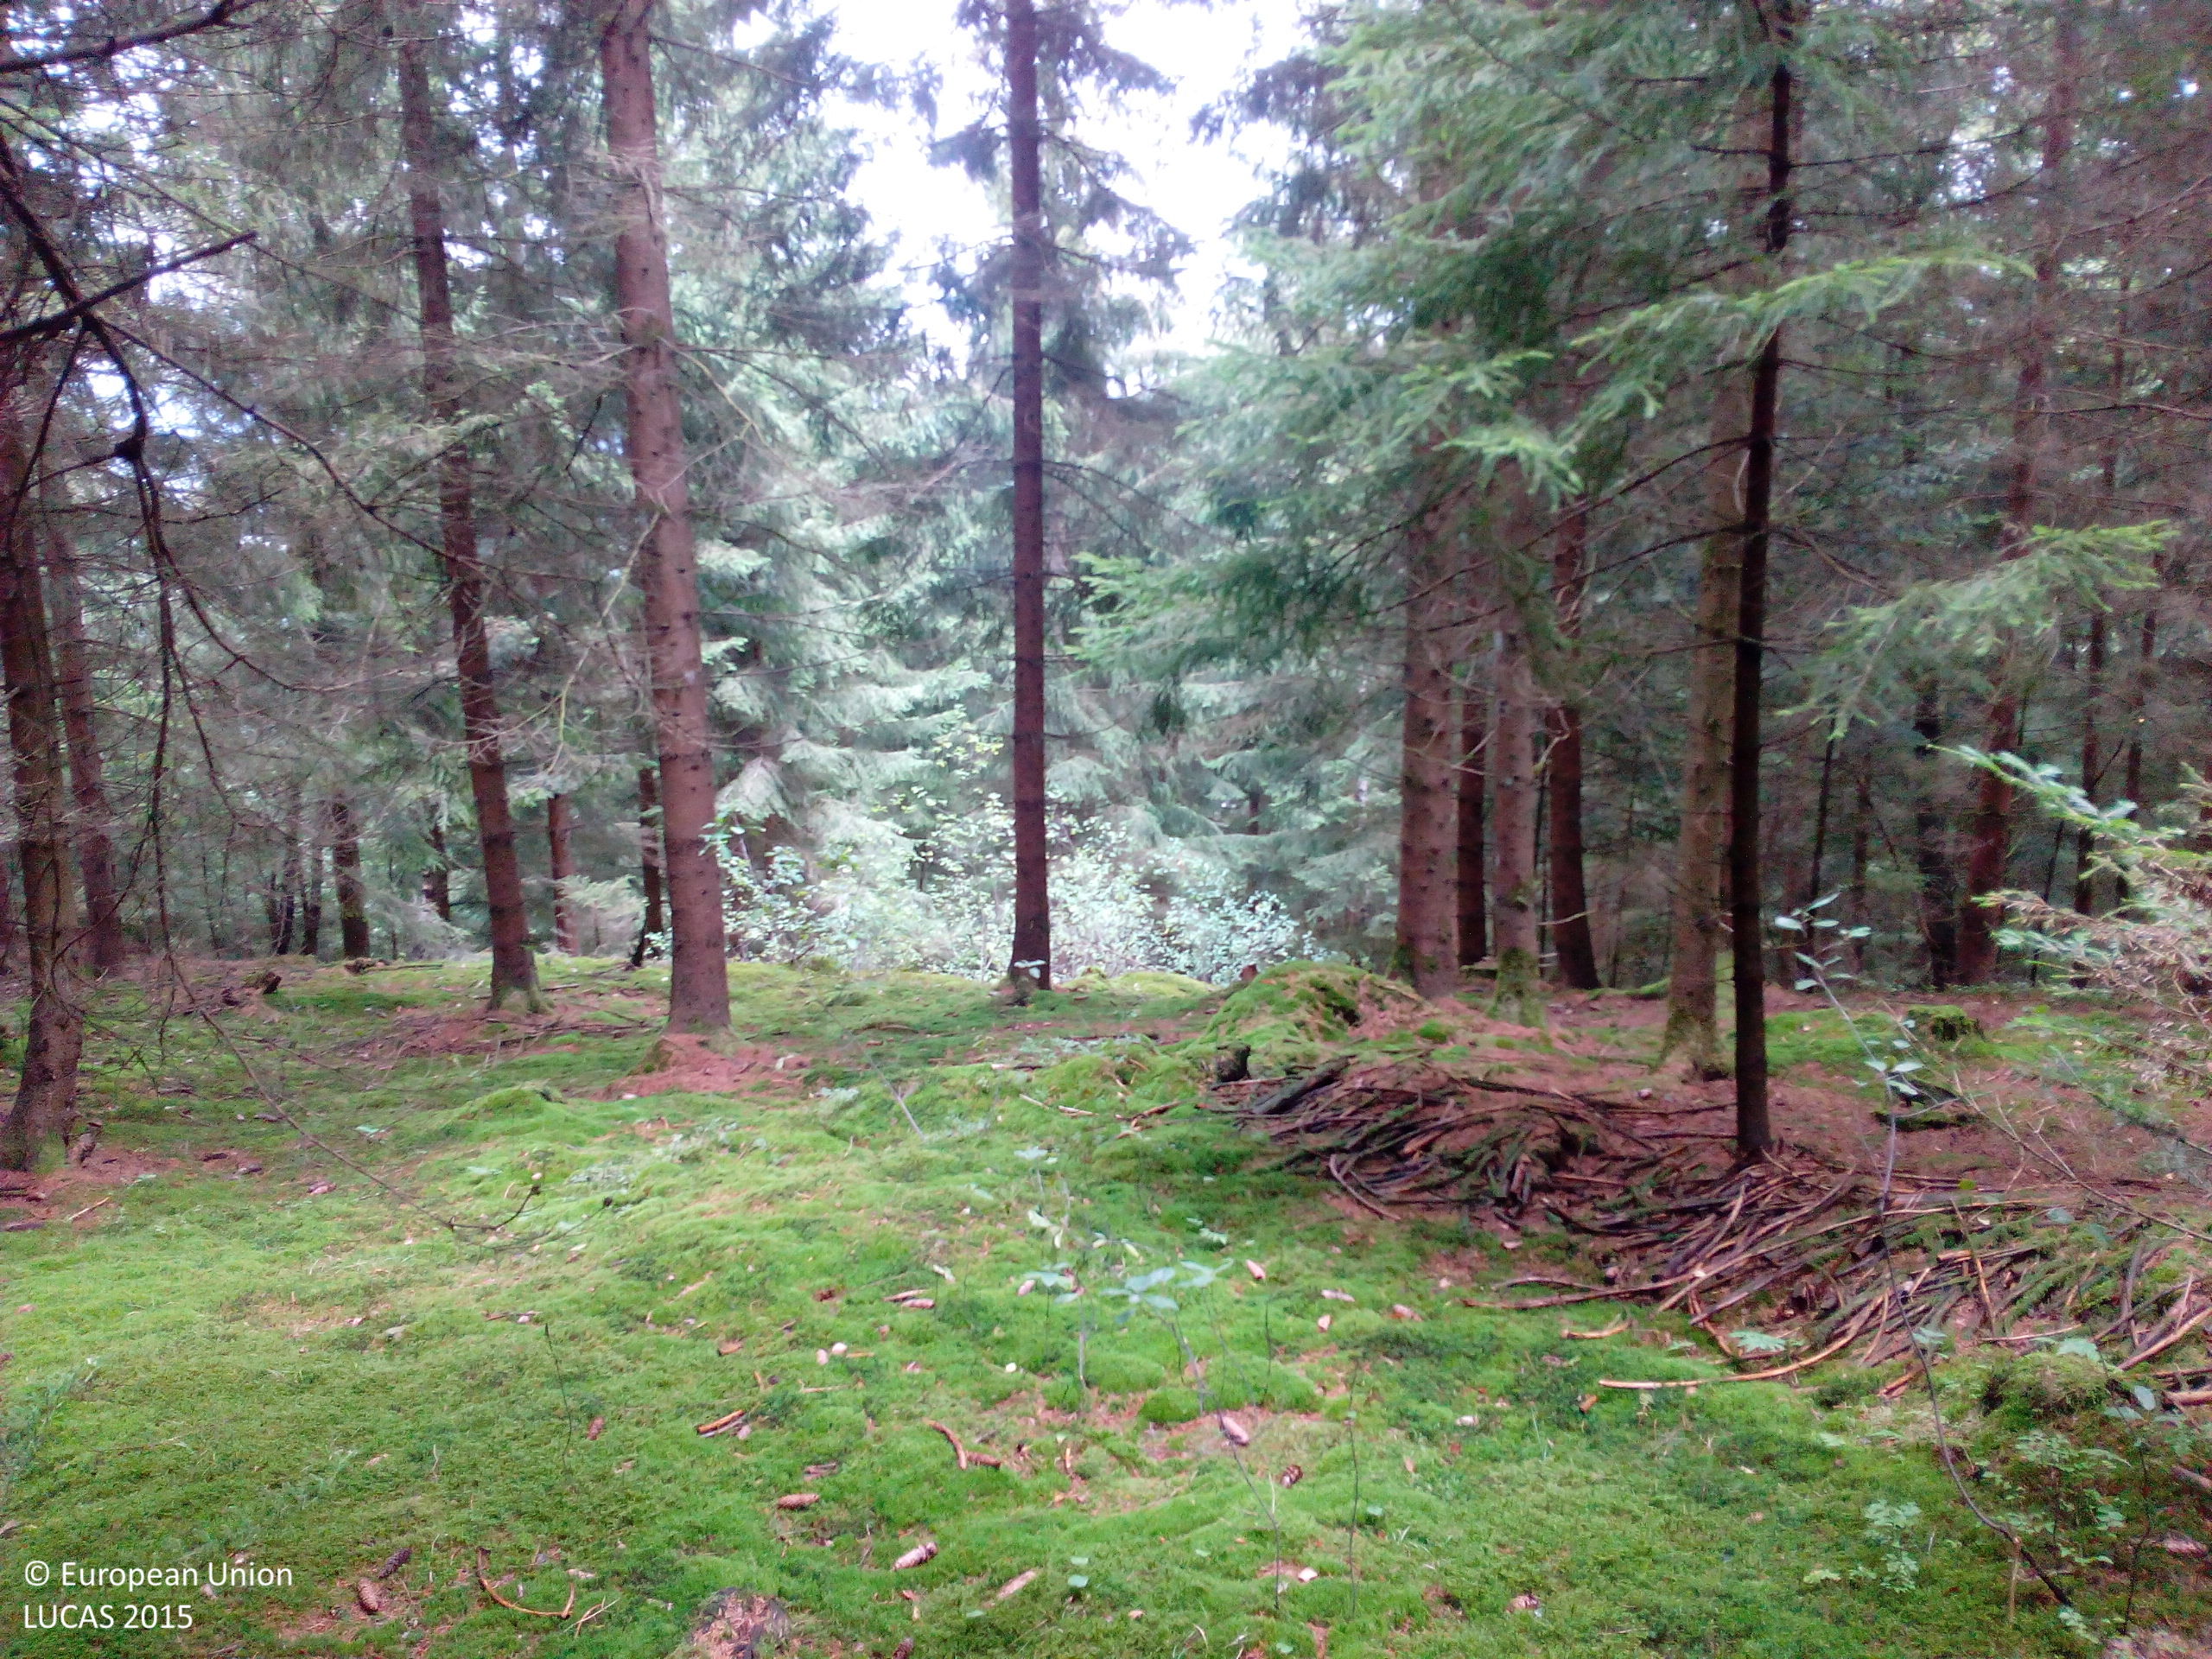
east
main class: Woodland
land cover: Spruce dominated coniferous woodland
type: hemiboreal forest and nemoral coniferous forest and mixed broadleaved-coniferous forest
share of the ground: > 75 %
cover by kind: coniferous forest trees 90 %, unconsolidated bare surface 10 %
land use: Forestry
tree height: > 5 m
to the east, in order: Spruce dominated coniferous woodland; Tracks; Other coniferous woodland; Other mixed woodland
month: September
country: DE
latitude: 48.9400
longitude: 12.9621
